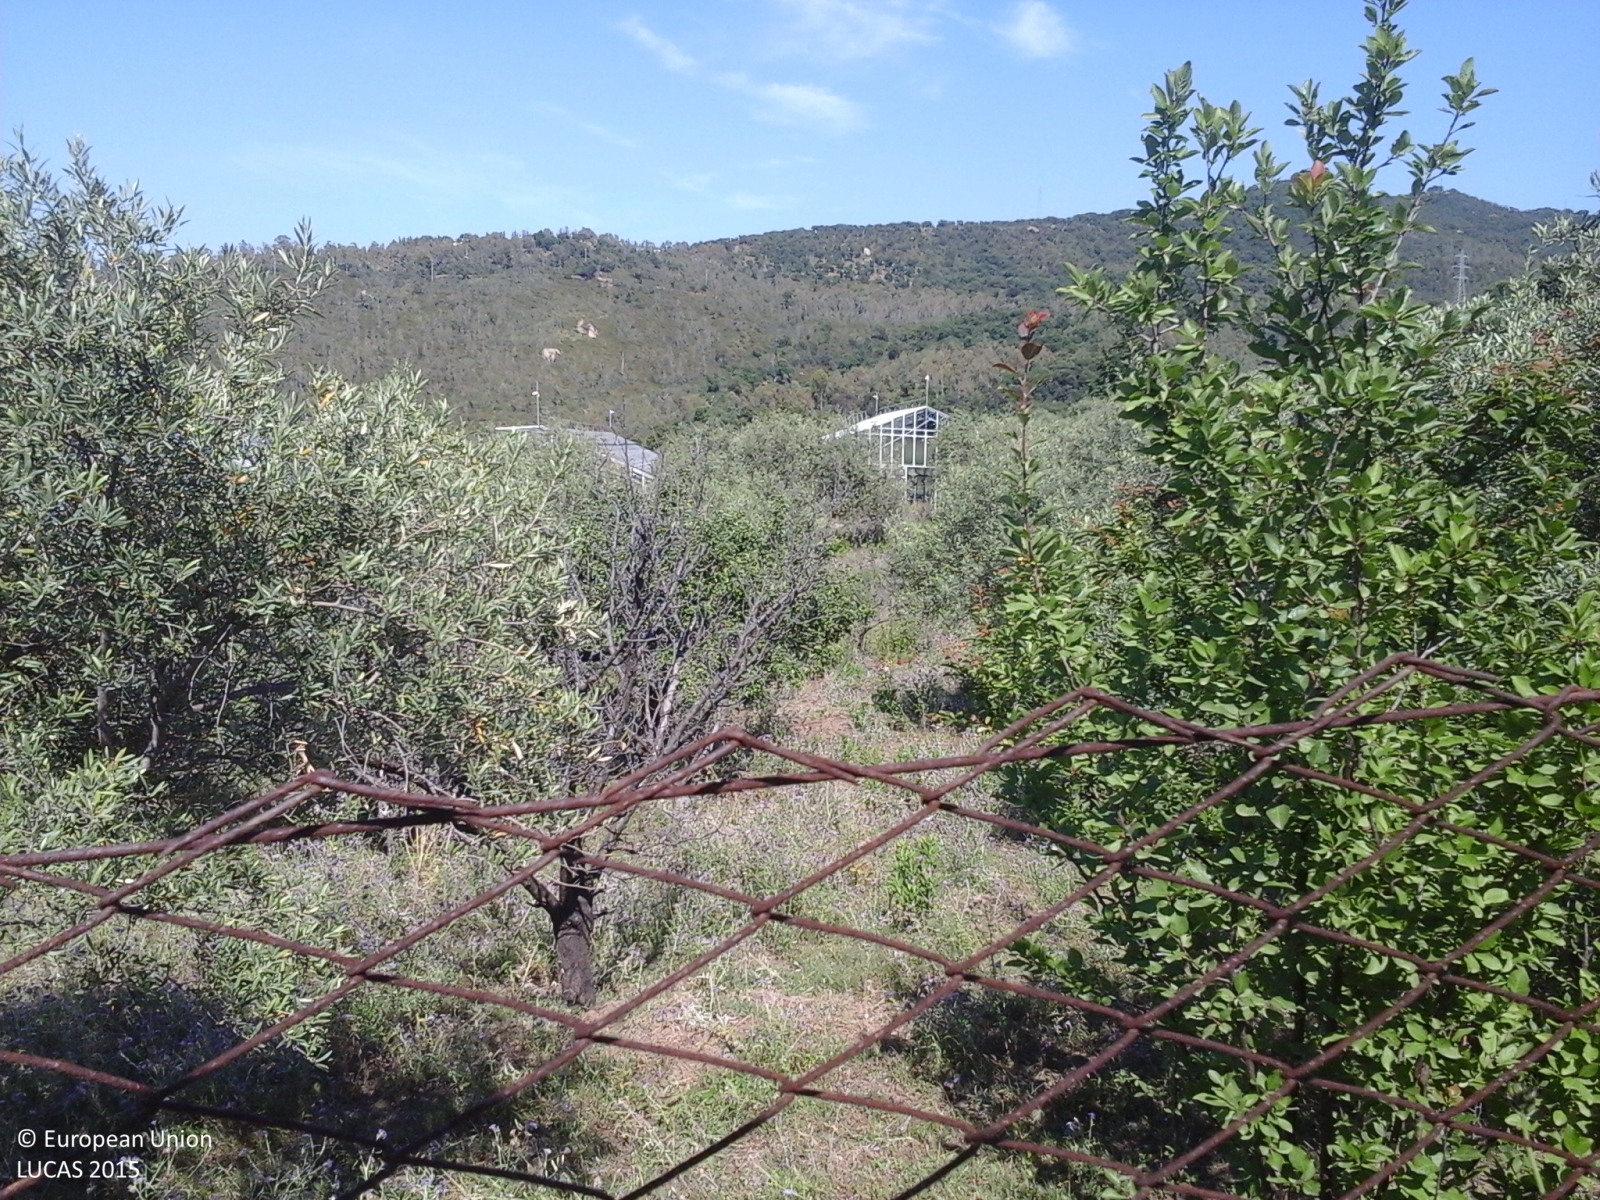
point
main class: Cropland
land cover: Olive groves
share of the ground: 50 - 75 %
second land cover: Spontaneously vegetated surfaces
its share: > 75 %
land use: Agriculture (excluding fallow land and kitchen gardens)
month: June
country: IT
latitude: 37.9927
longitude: 13.9465
